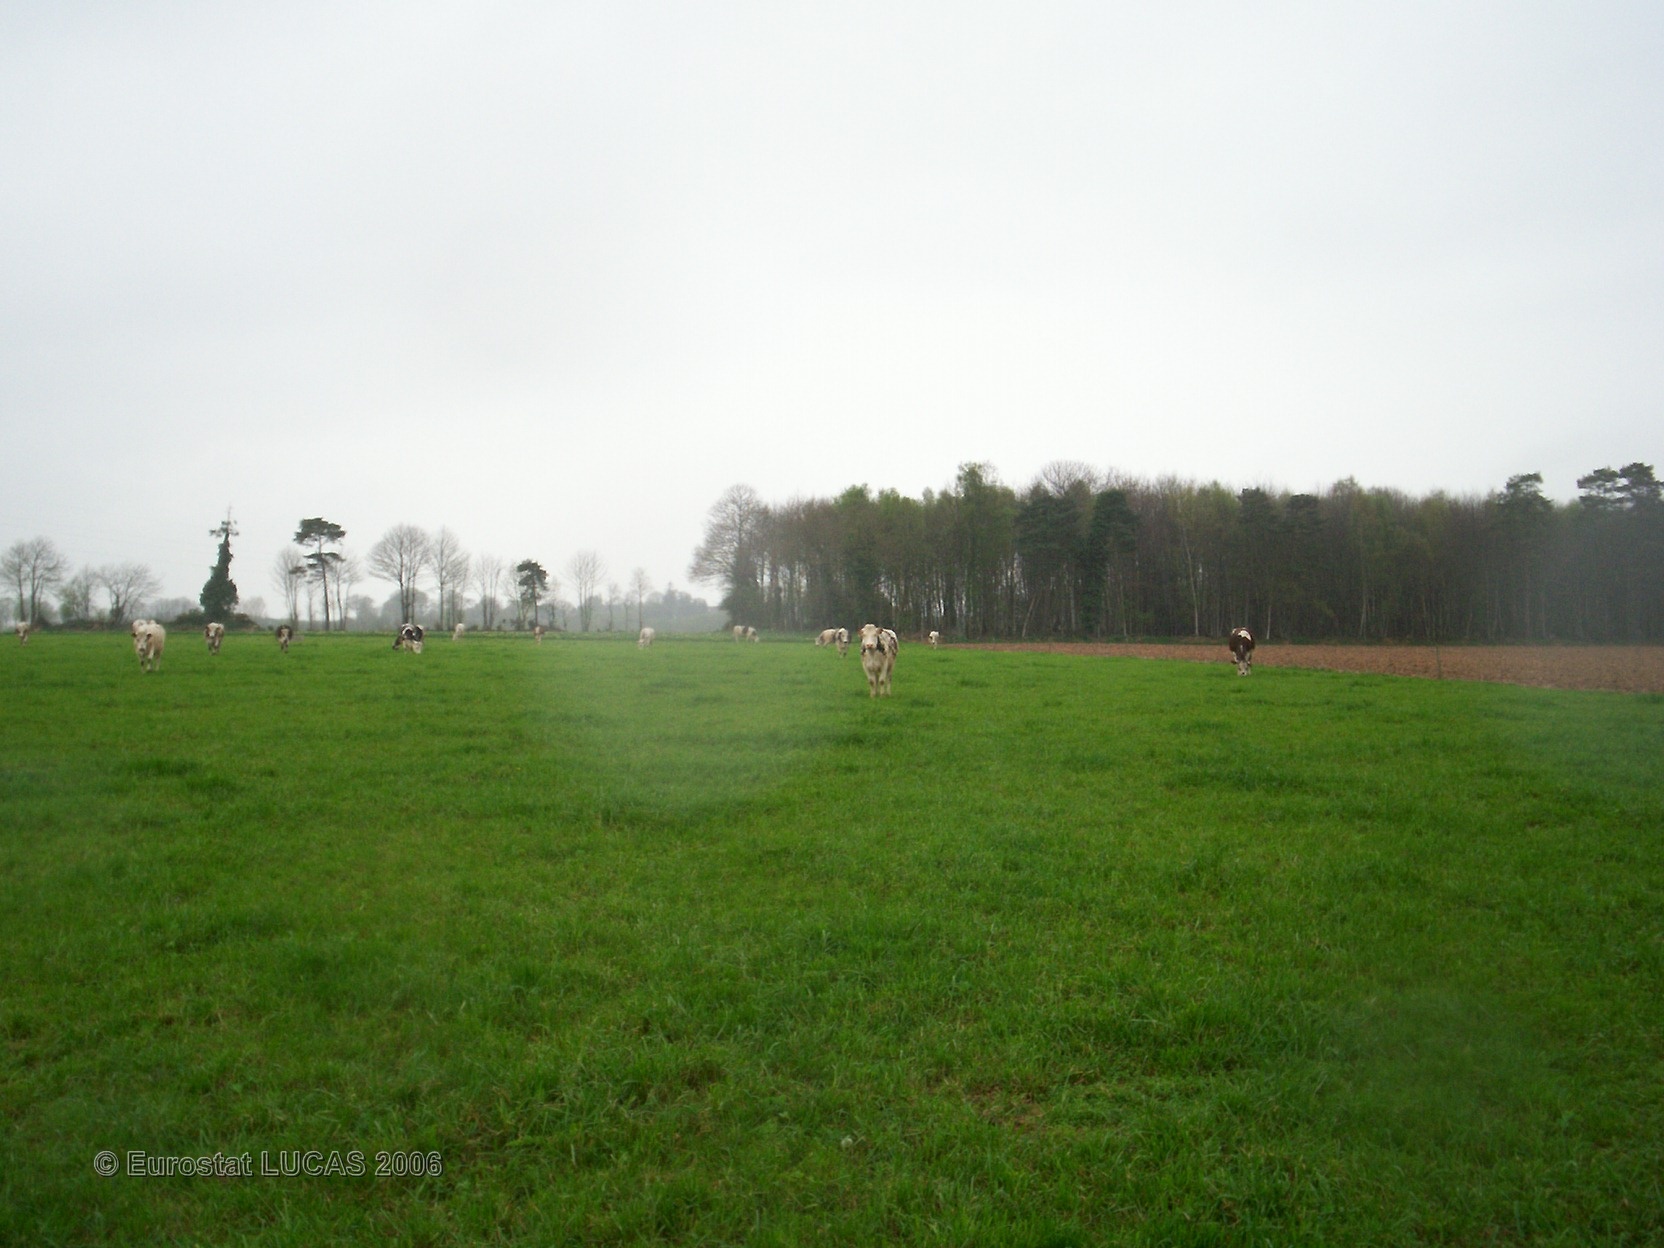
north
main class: Grassland
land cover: Grassland without tree/shrub cover
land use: Agriculture (excluding fallow land and kitchen gardens)
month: April
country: FR
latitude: 48.1382
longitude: -2.4087
